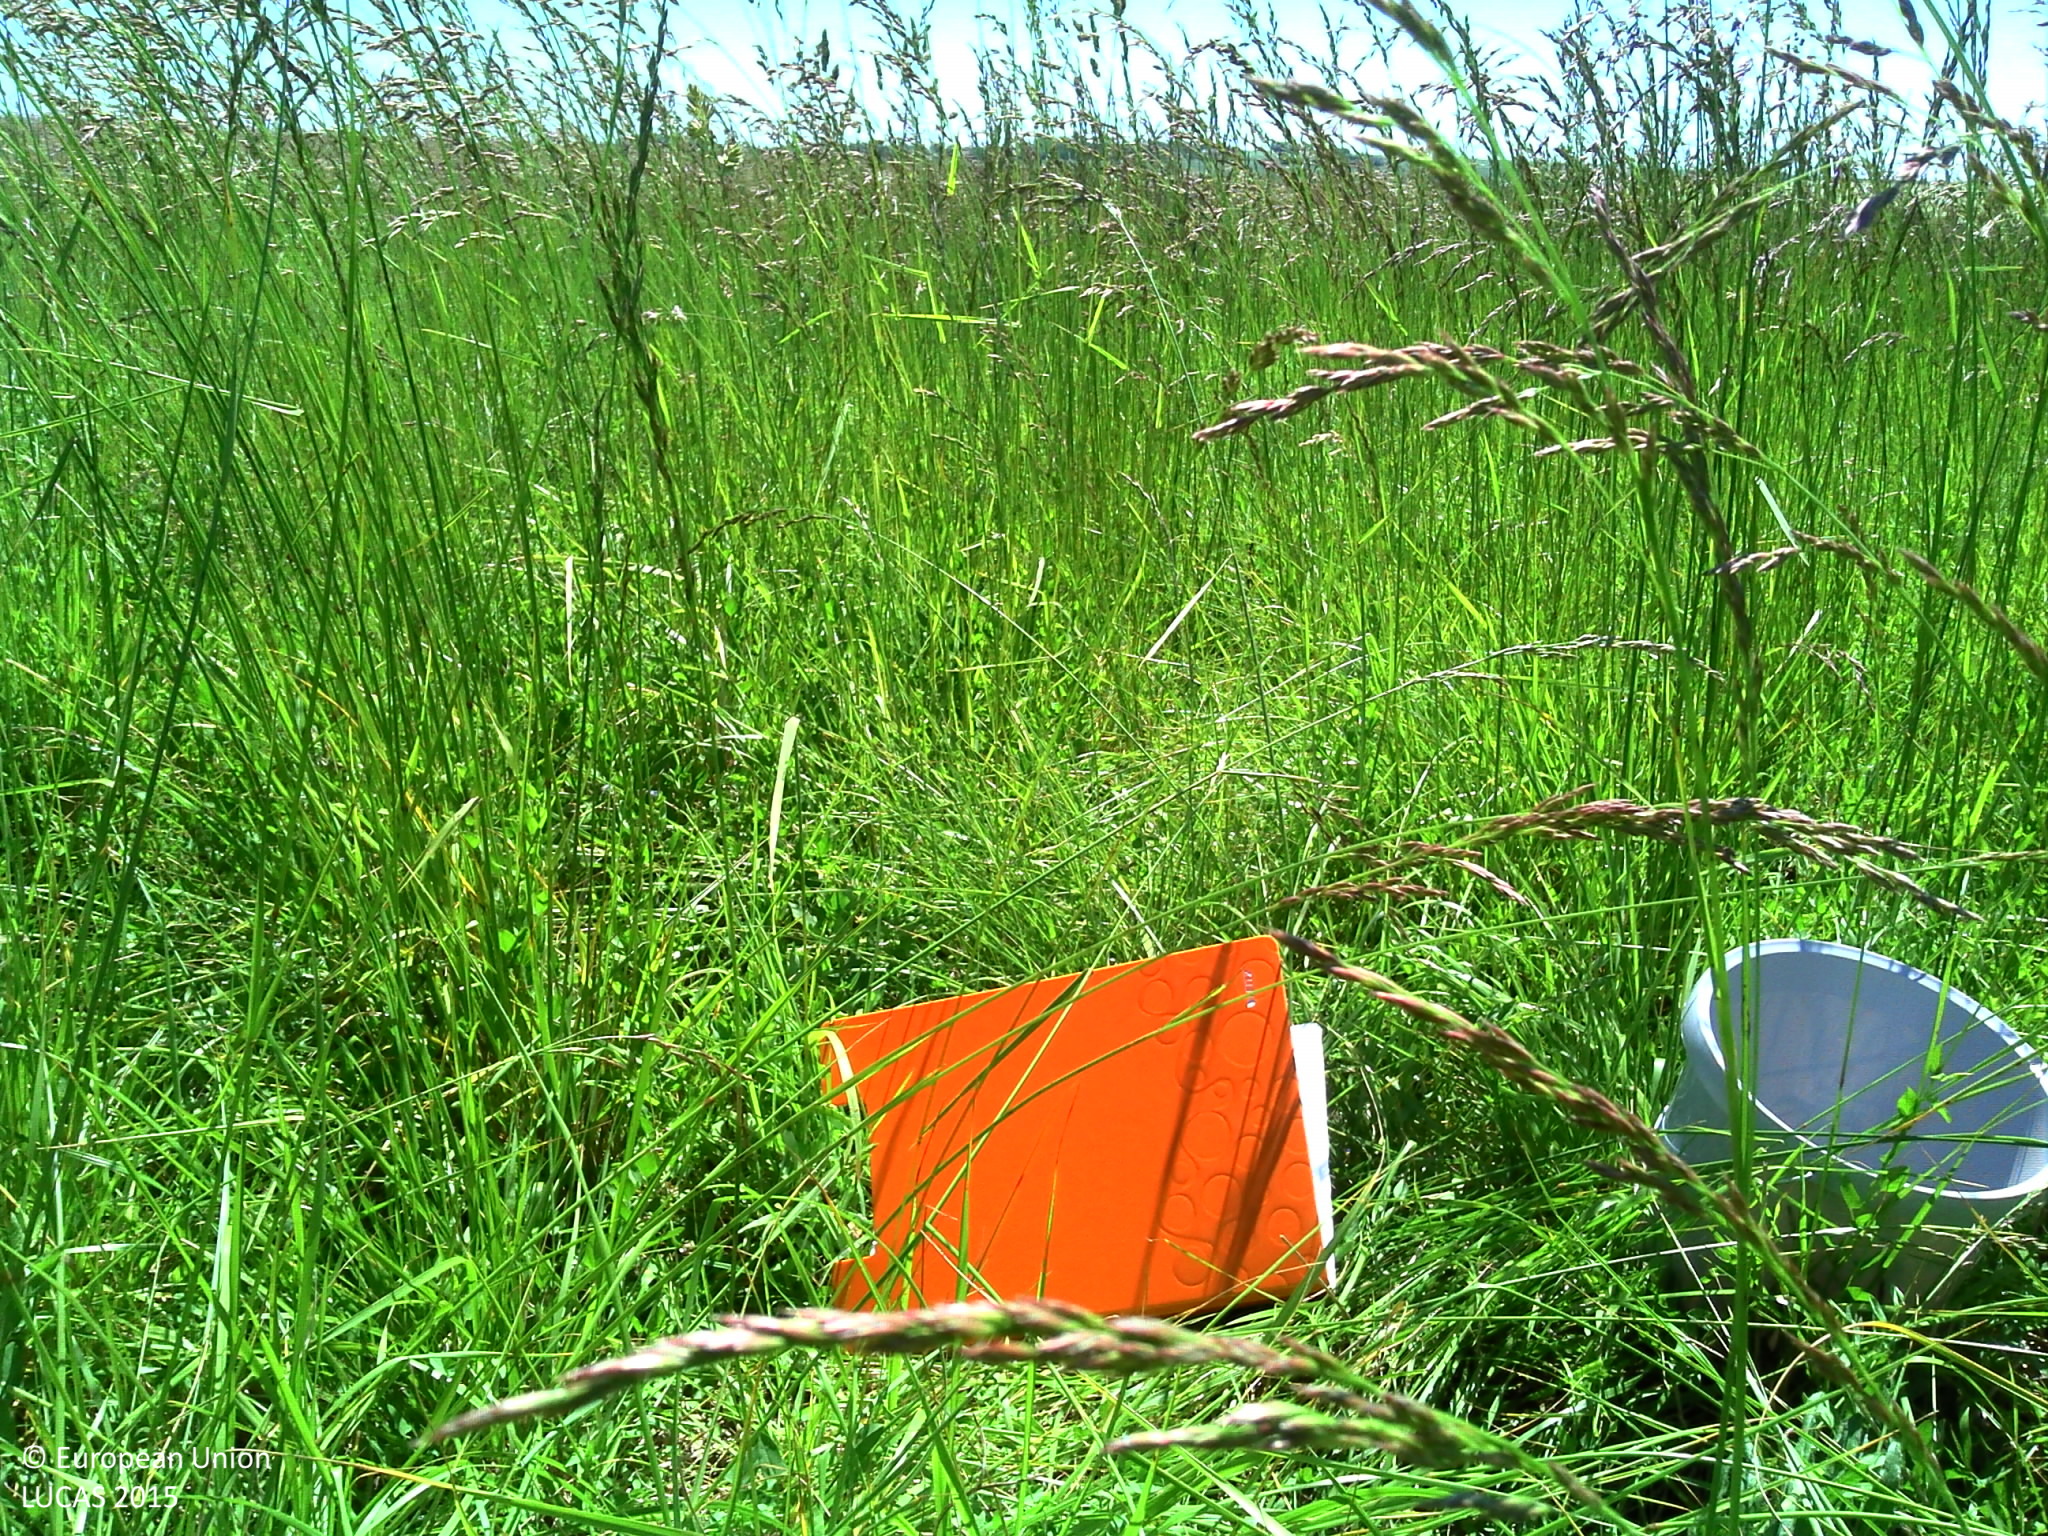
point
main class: Grassland
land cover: Grassland without tree/shrub cover
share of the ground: > 75 %
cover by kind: herbaceous plants 100 %
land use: Agriculture (excluding fallow land and kitchen gardens)
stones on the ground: 10 - 25 %
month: June
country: FR
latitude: 47.0642
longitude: 2.7659
